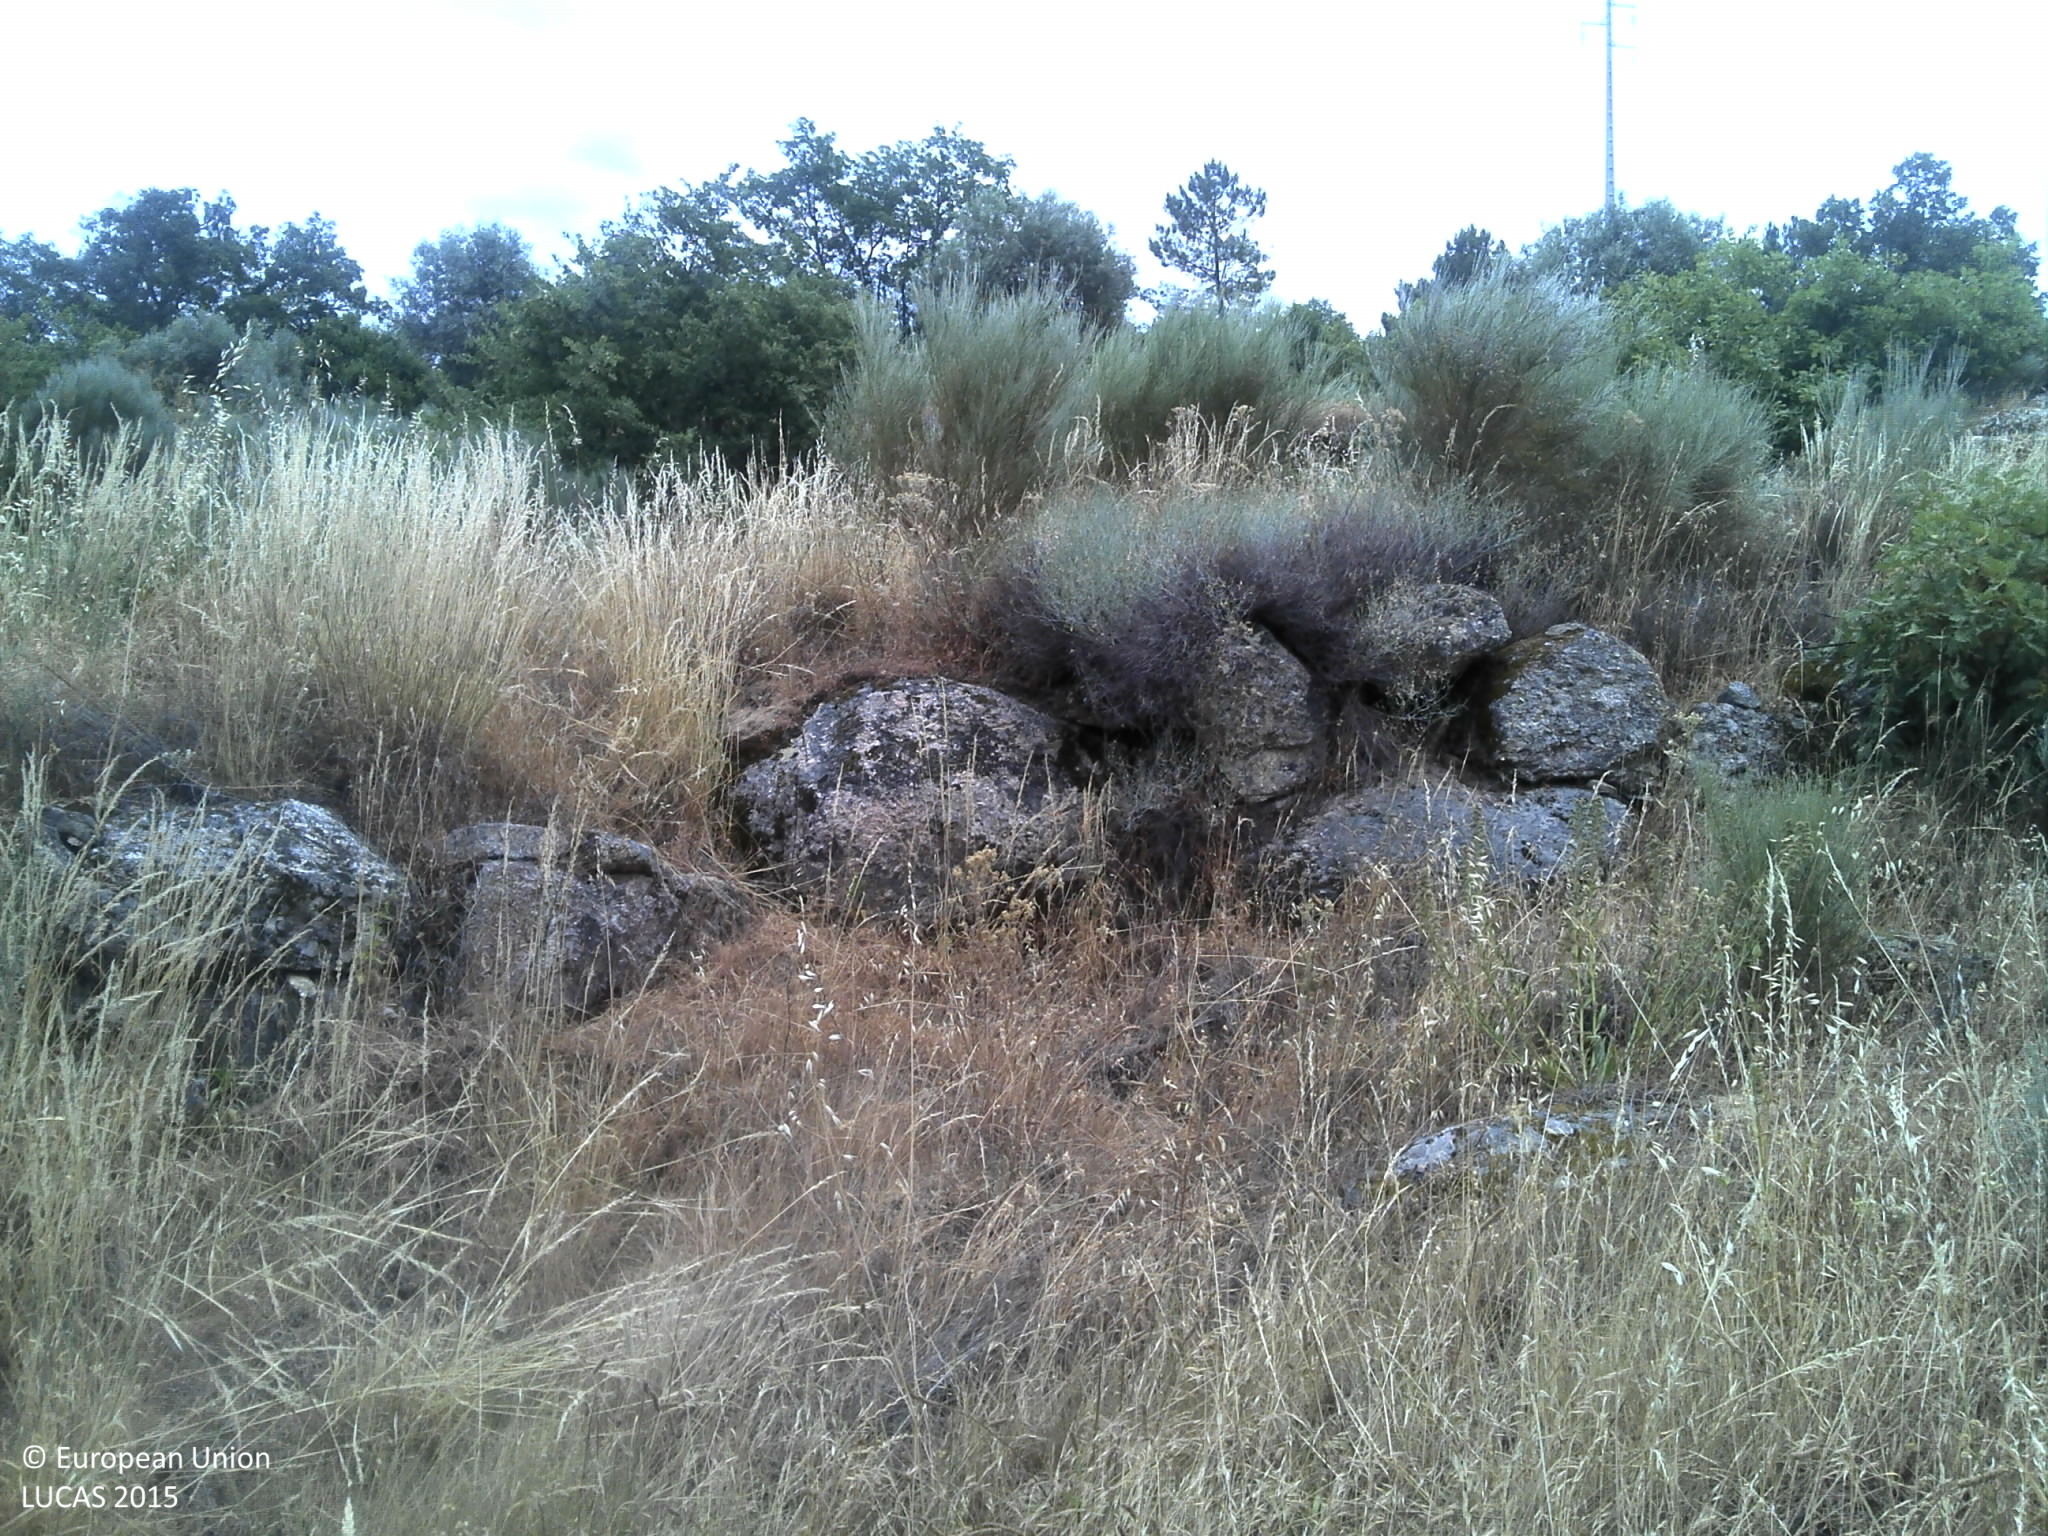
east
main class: Shrubland
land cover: Shrubland with sparse tree cover
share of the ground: 50 - 75 %
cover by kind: shrubs 55 %, herbaceous plants 30 %, broadleaved forest trees 5 %, unconsolidated bare surface 5 %
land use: Abandoned areas
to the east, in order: Shrubland with sparse tree cover; Rock outcrops; Shrubland with sparse tree cover; Dry stone walls; Spontaneously vegetated surfaces; Electric lines; Spontaneously vegetated surfaces; Dry stone walls; Spontaneously vegetated surfaces; Tracks; Spontaneously vegetated surfaces; Pine dominated coniferous woodland; Dry stone walls; Spontaneously vegetated surfaces; Dry stone walls; Tracks; Electric lines; Shrubland with sparse tree cover
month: June
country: PT
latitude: 40.3134
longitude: -7.2465
